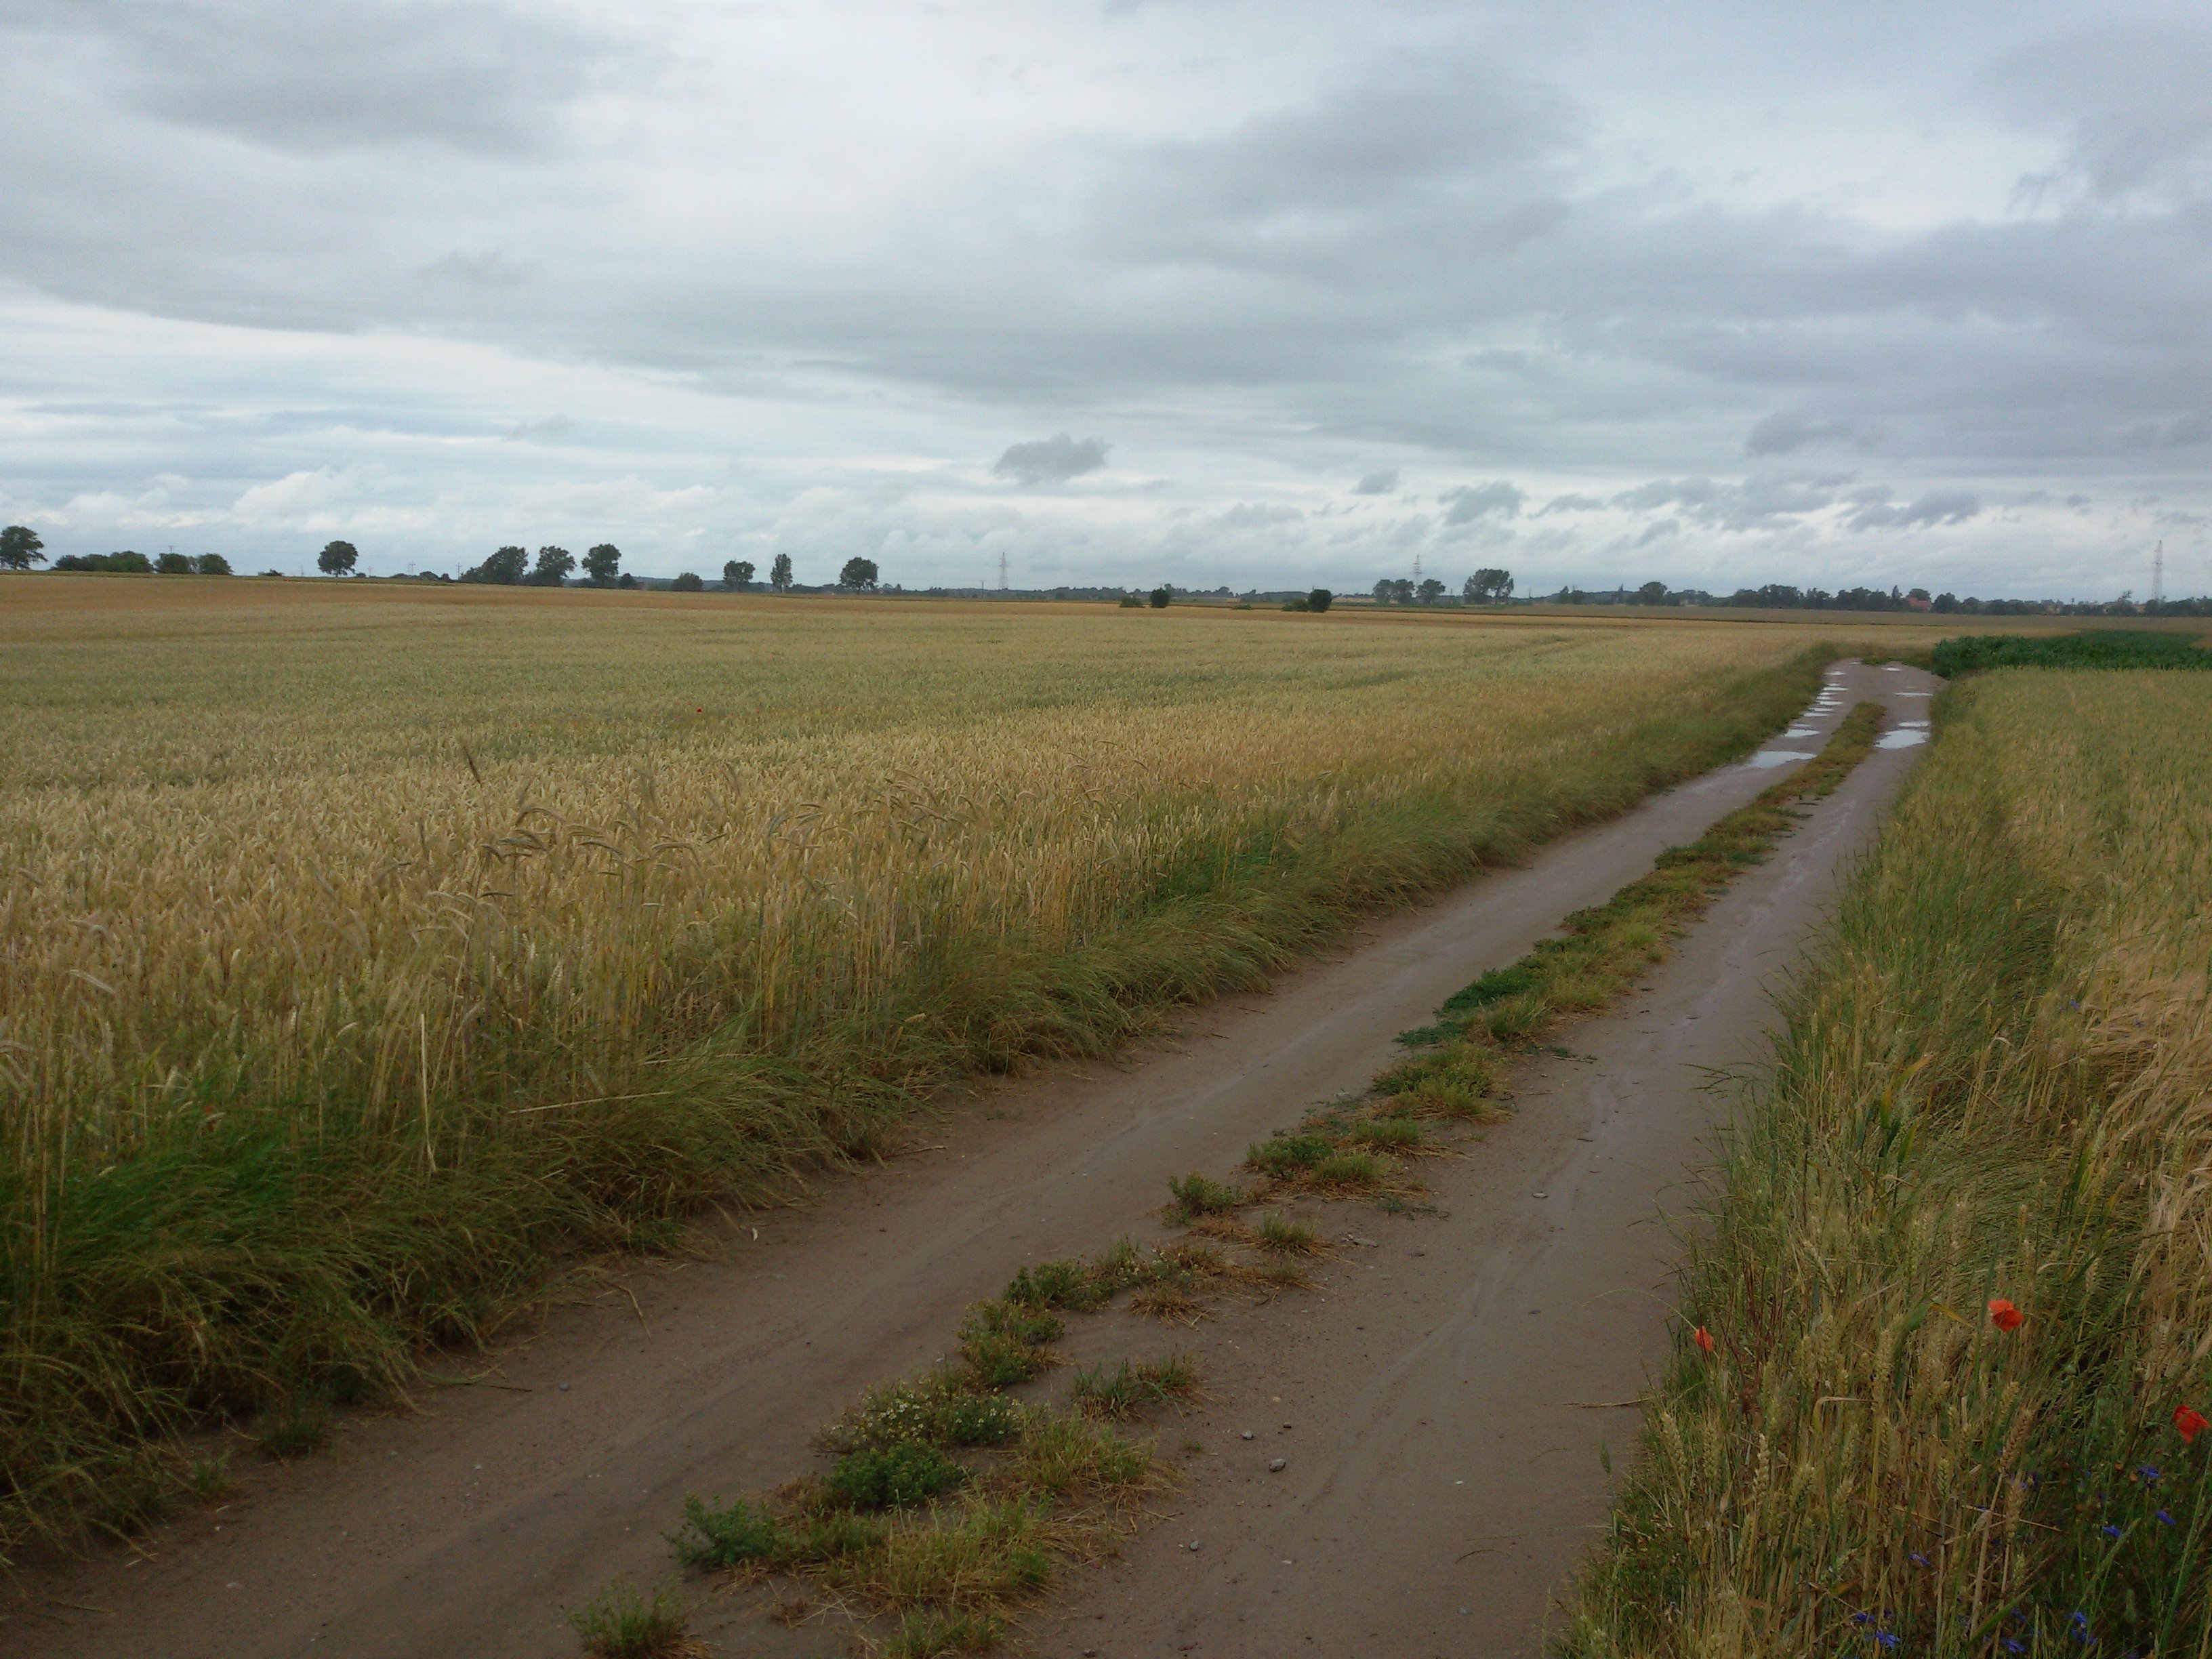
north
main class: Cropland
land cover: Barley
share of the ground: > 75 %
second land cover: Common wheat
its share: > 75 %
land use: Agriculture (excluding fallow land and kitchen gardens)
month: July
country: PL
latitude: 52.8897
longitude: 17.6376
